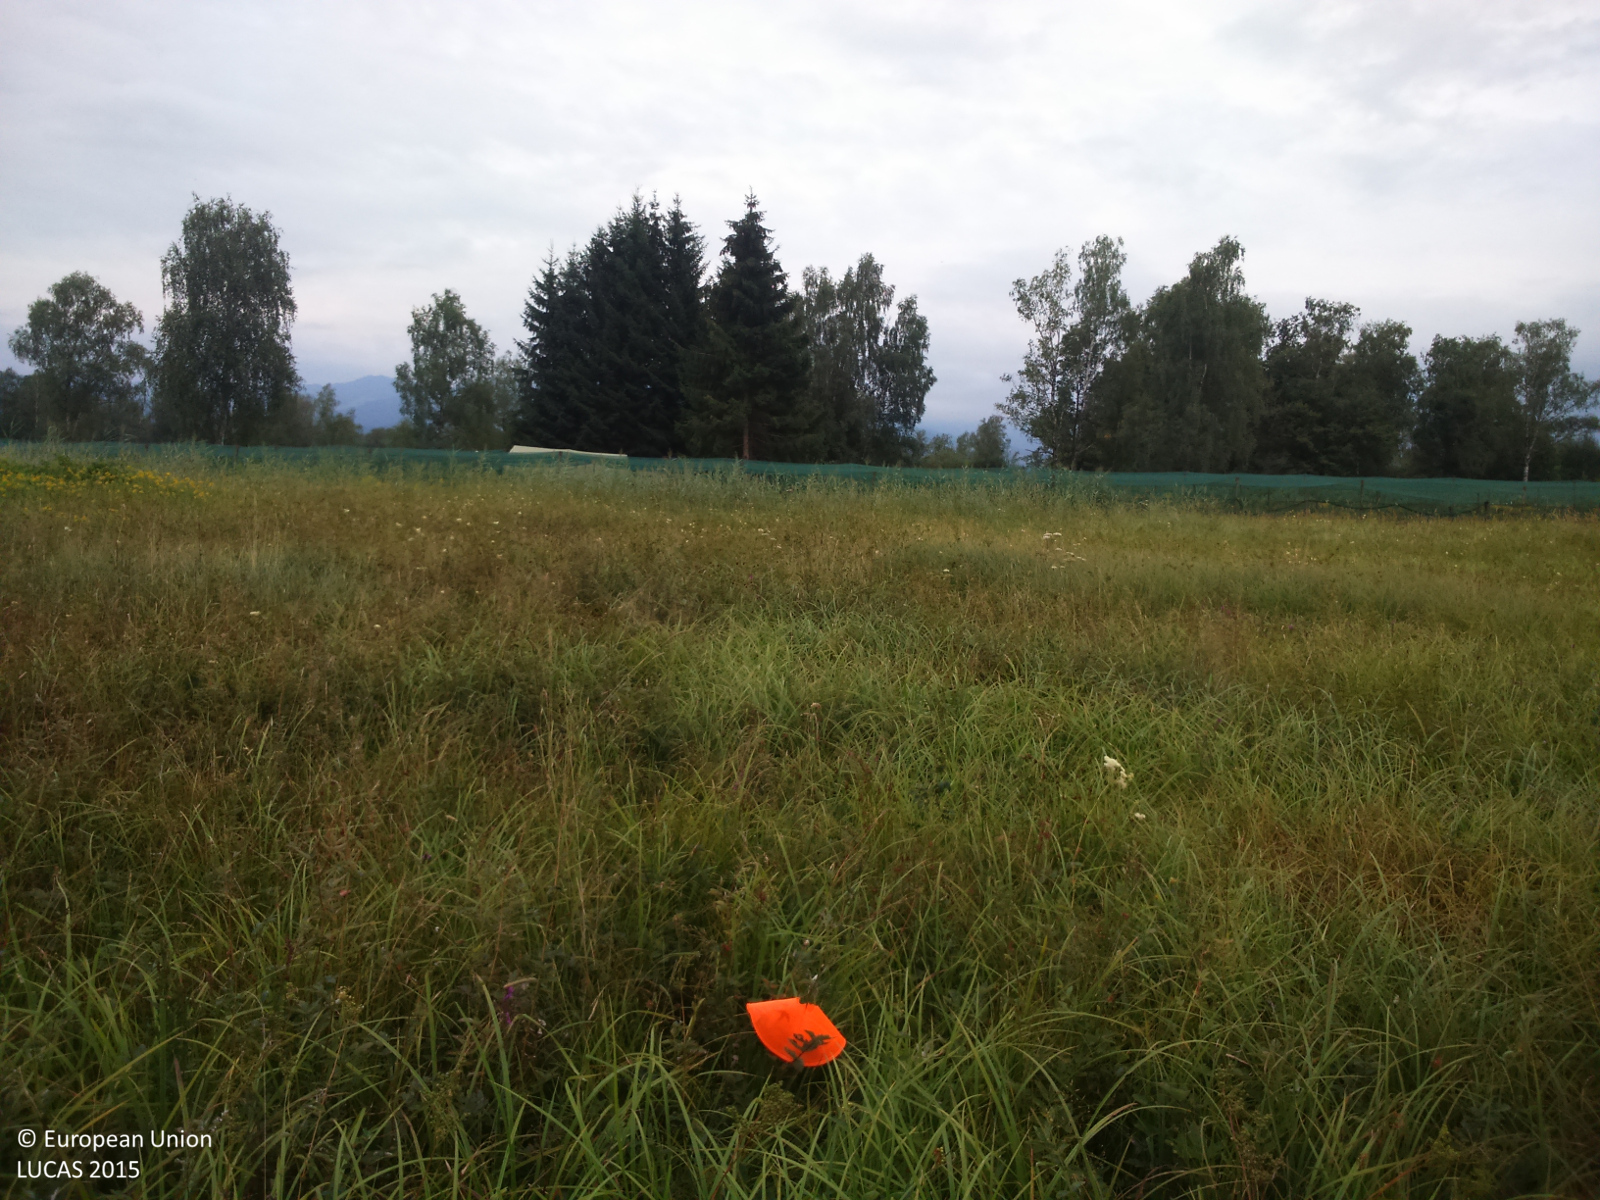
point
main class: Grassland
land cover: Grassland without tree/shrub cover
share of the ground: > 75 %
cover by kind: herbaceous plants 100 %
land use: Agriculture (excluding fallow land and kitchen gardens)
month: August
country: AT
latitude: 47.4672
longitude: 9.6951
